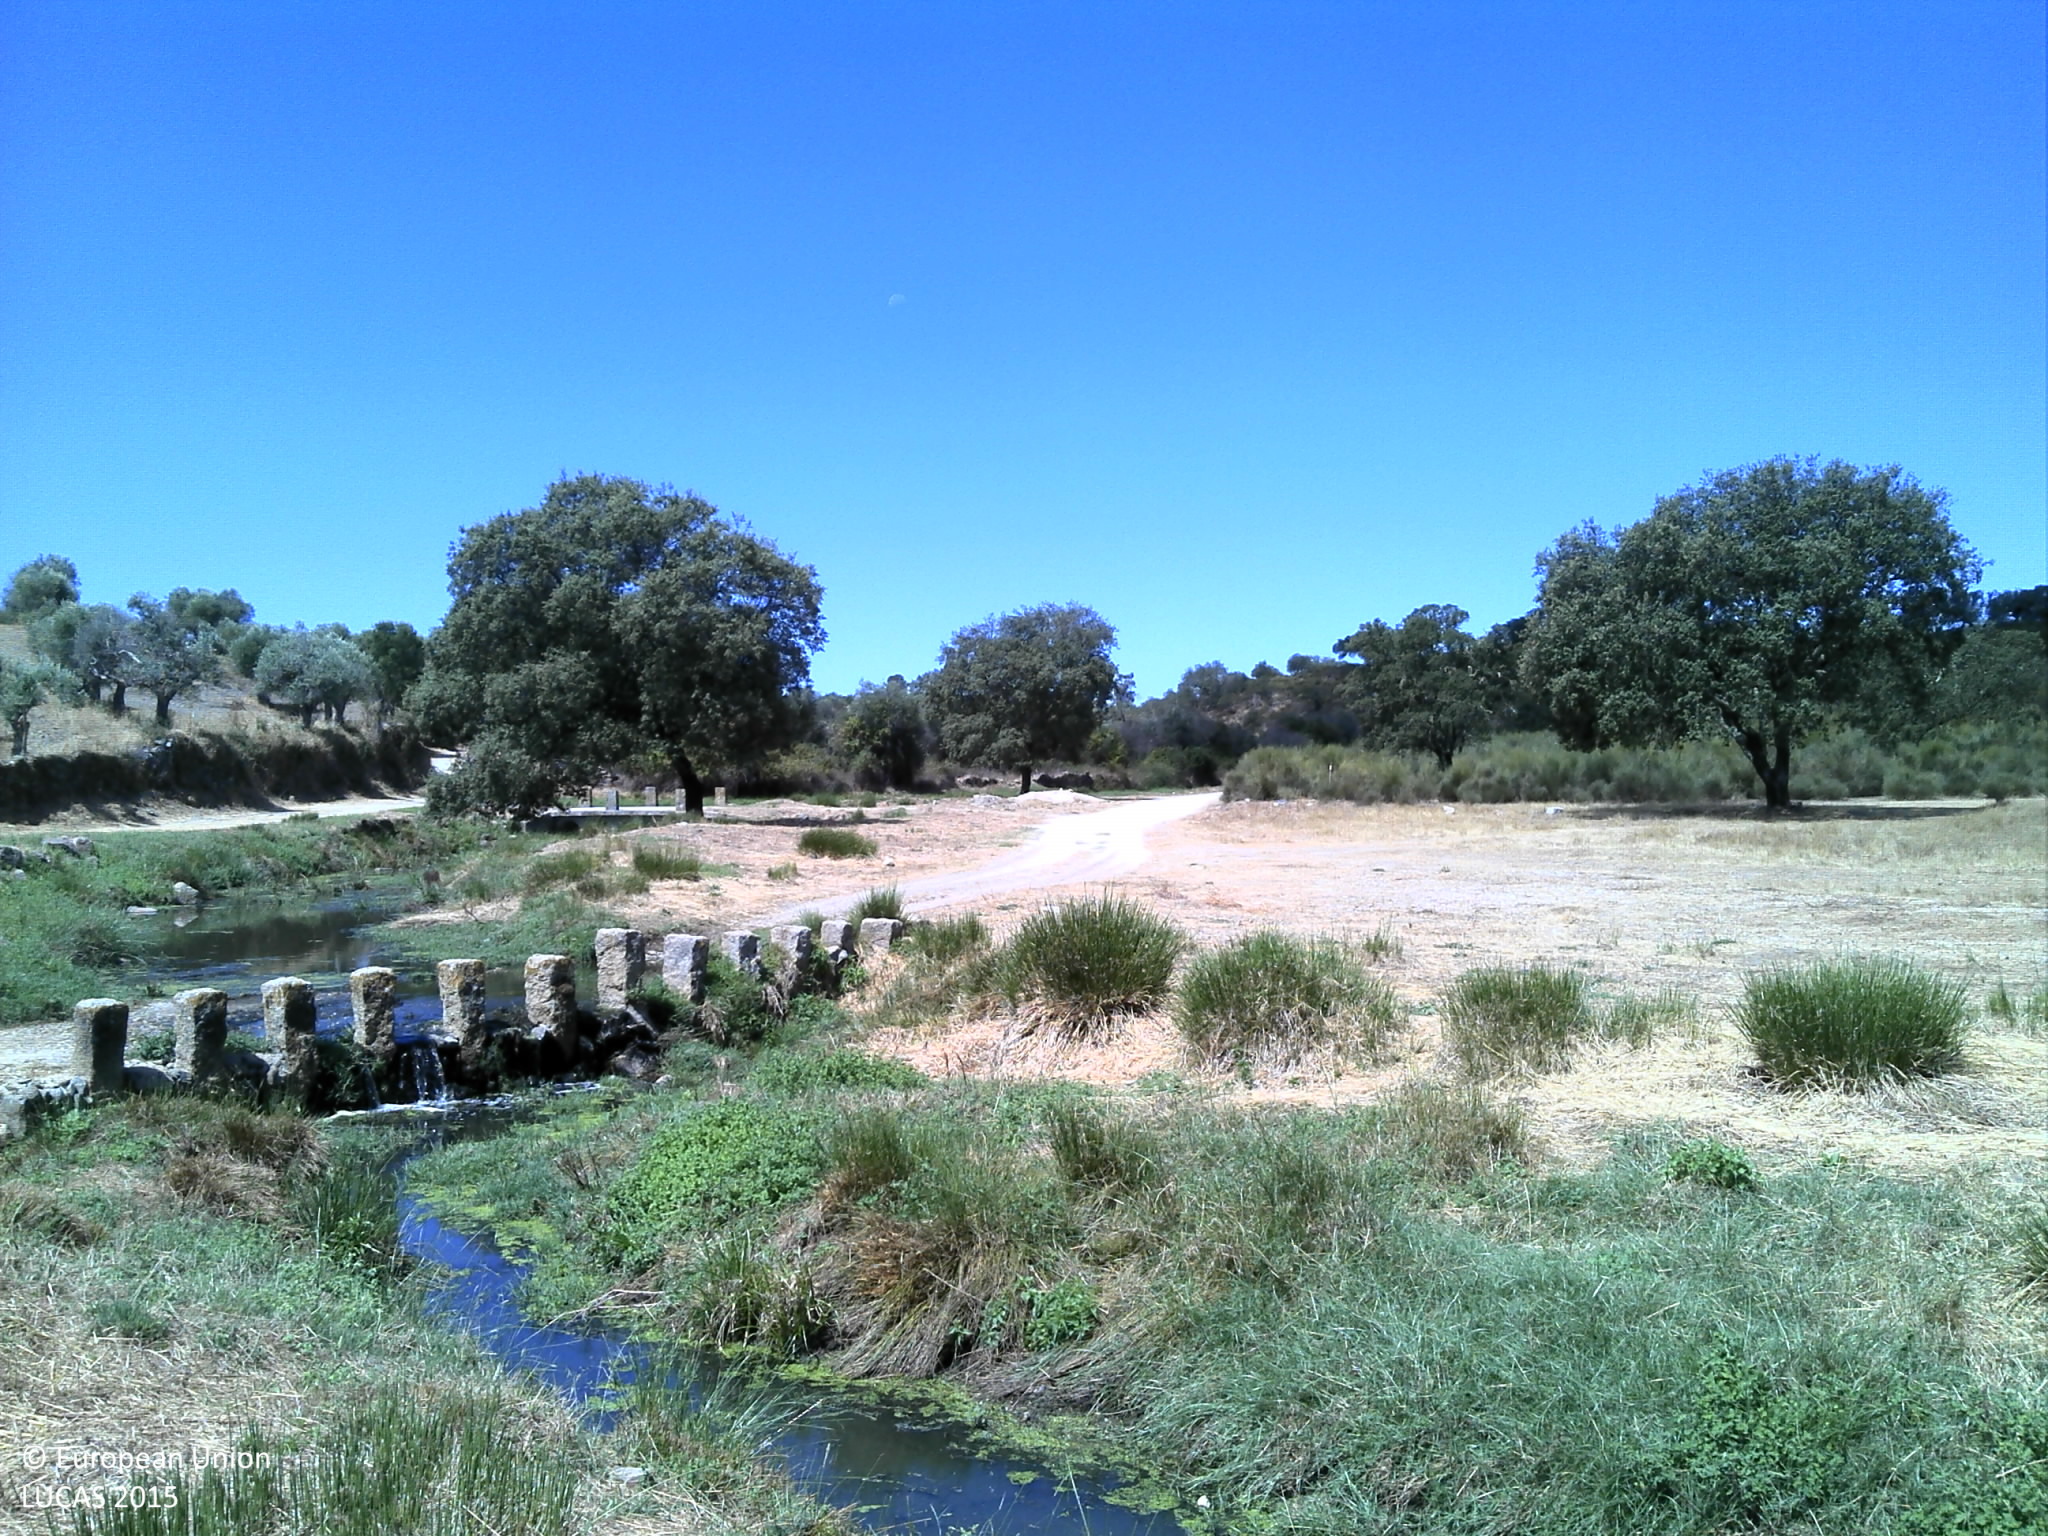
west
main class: Grassland
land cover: Grassland without tree/shrub cover
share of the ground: > 75 %
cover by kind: herbaceous plants 75 %, unconsolidated bare surface 25 %
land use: Agriculture (excluding fallow land and kitchen gardens)
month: August
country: PT
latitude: 39.5249
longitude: -7.6279
